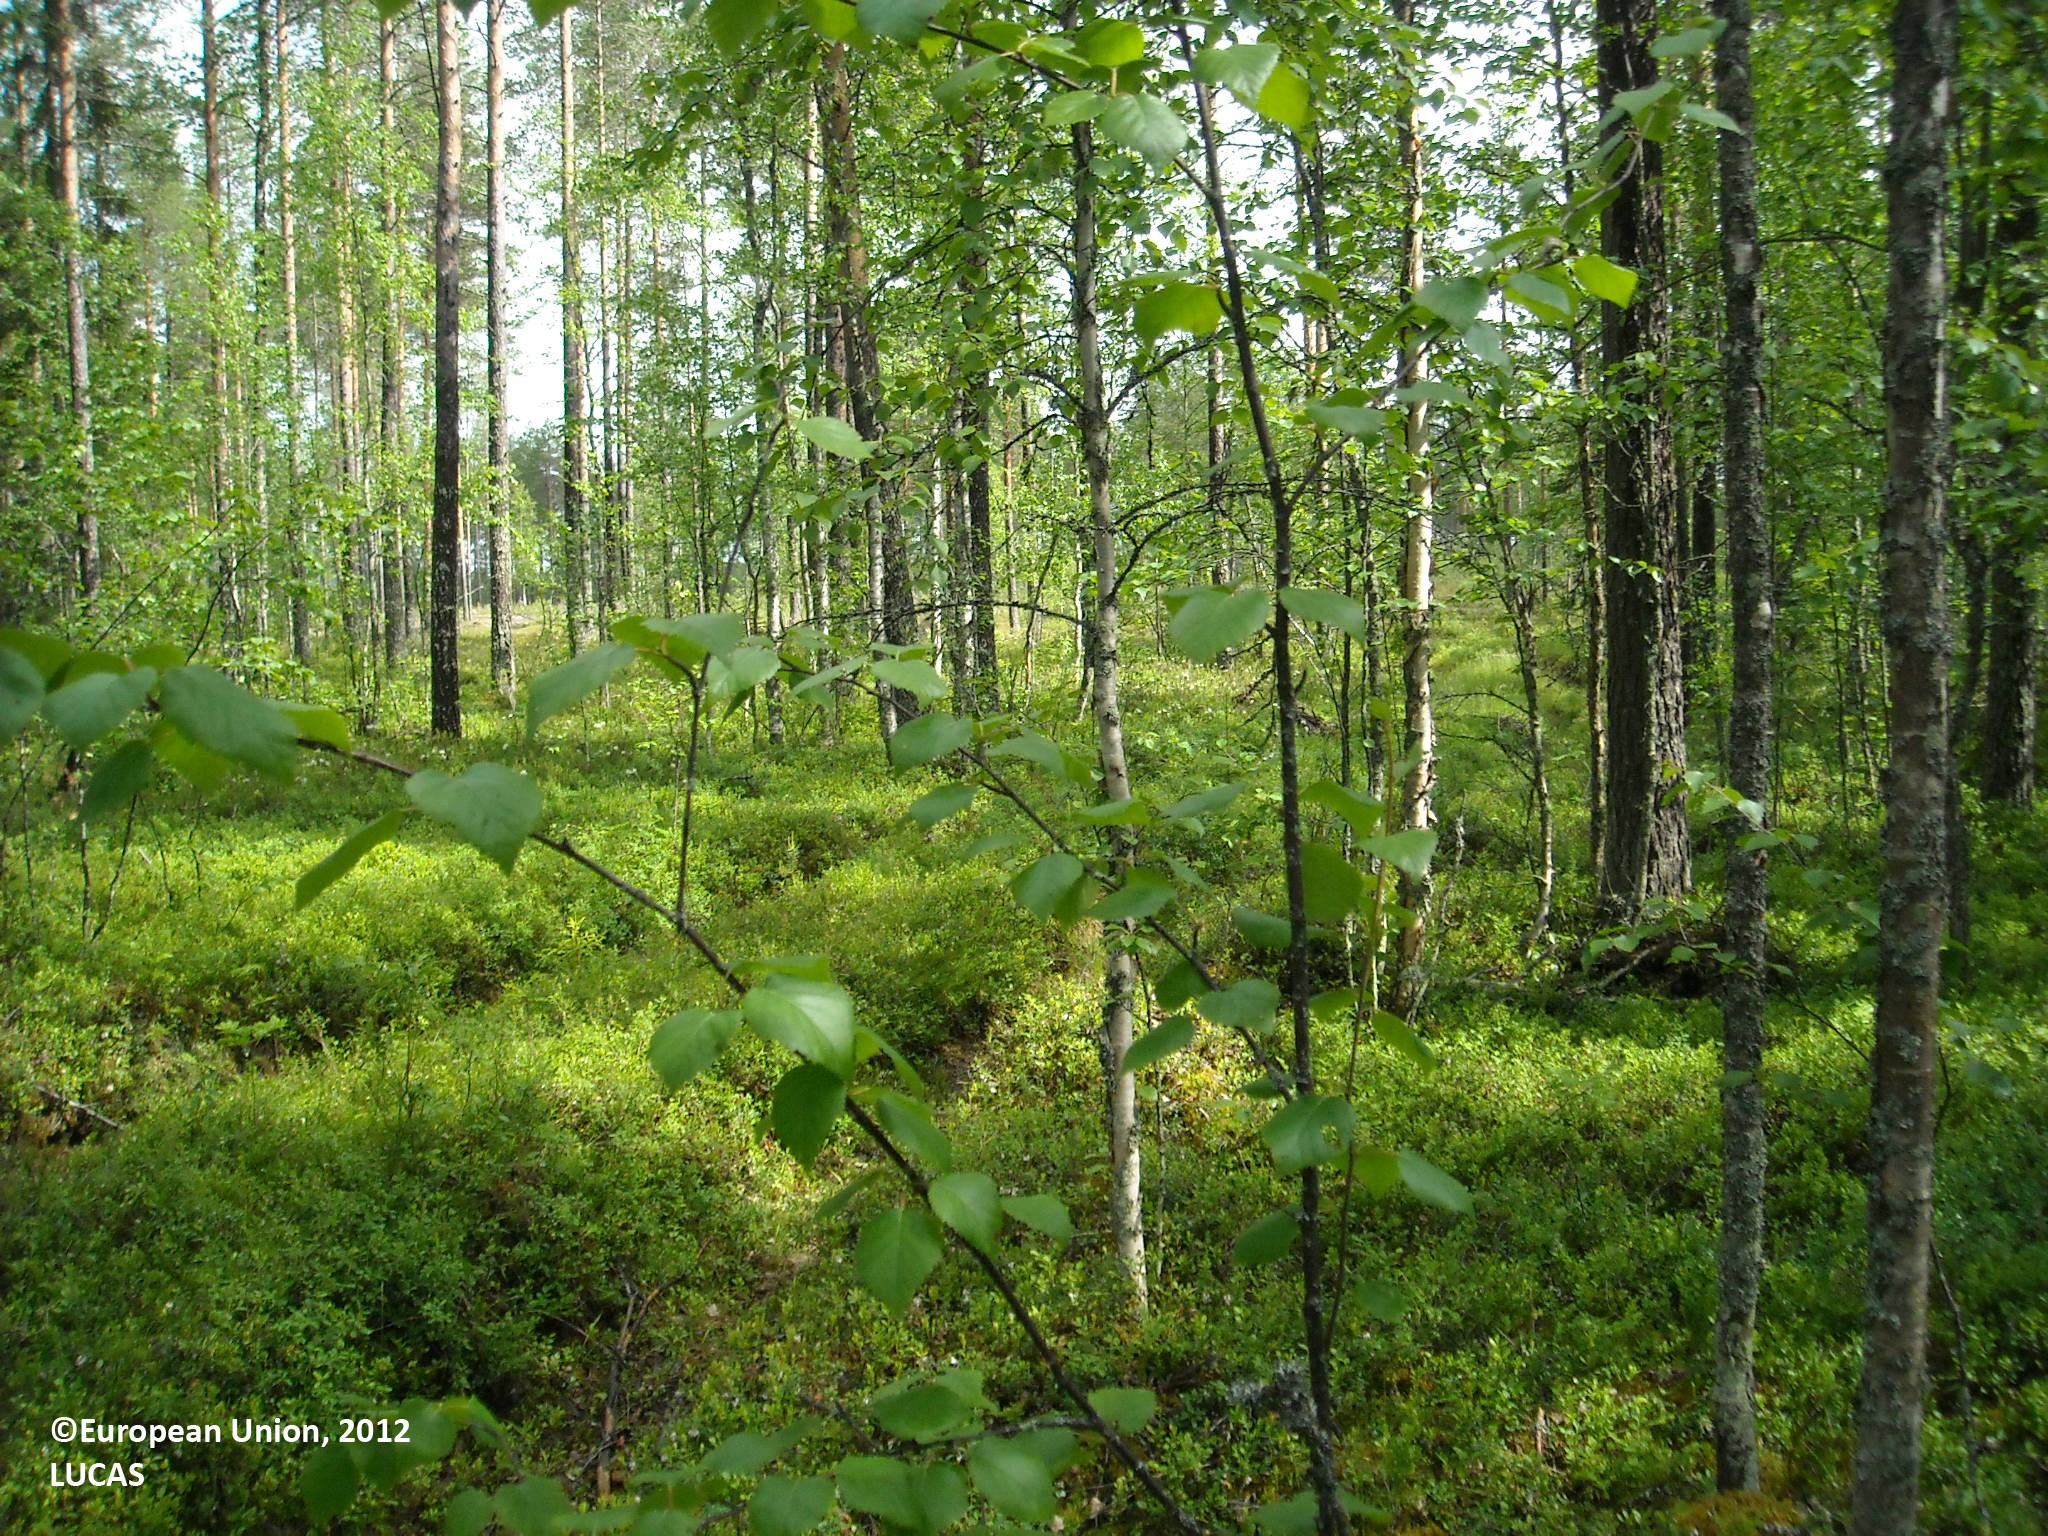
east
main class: Woodland
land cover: Pine dominated mixed woodland
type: boreal forest
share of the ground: > 75 %
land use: Forestry
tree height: > 5 m
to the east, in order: Pine dominated mixed woodland; Tracks; Pine dominated mixed woodland; Paved roads, cycling and walking lanes; Pine dominated coniferous woodland
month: July
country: FI
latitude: 65.0797
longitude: 28.0843
